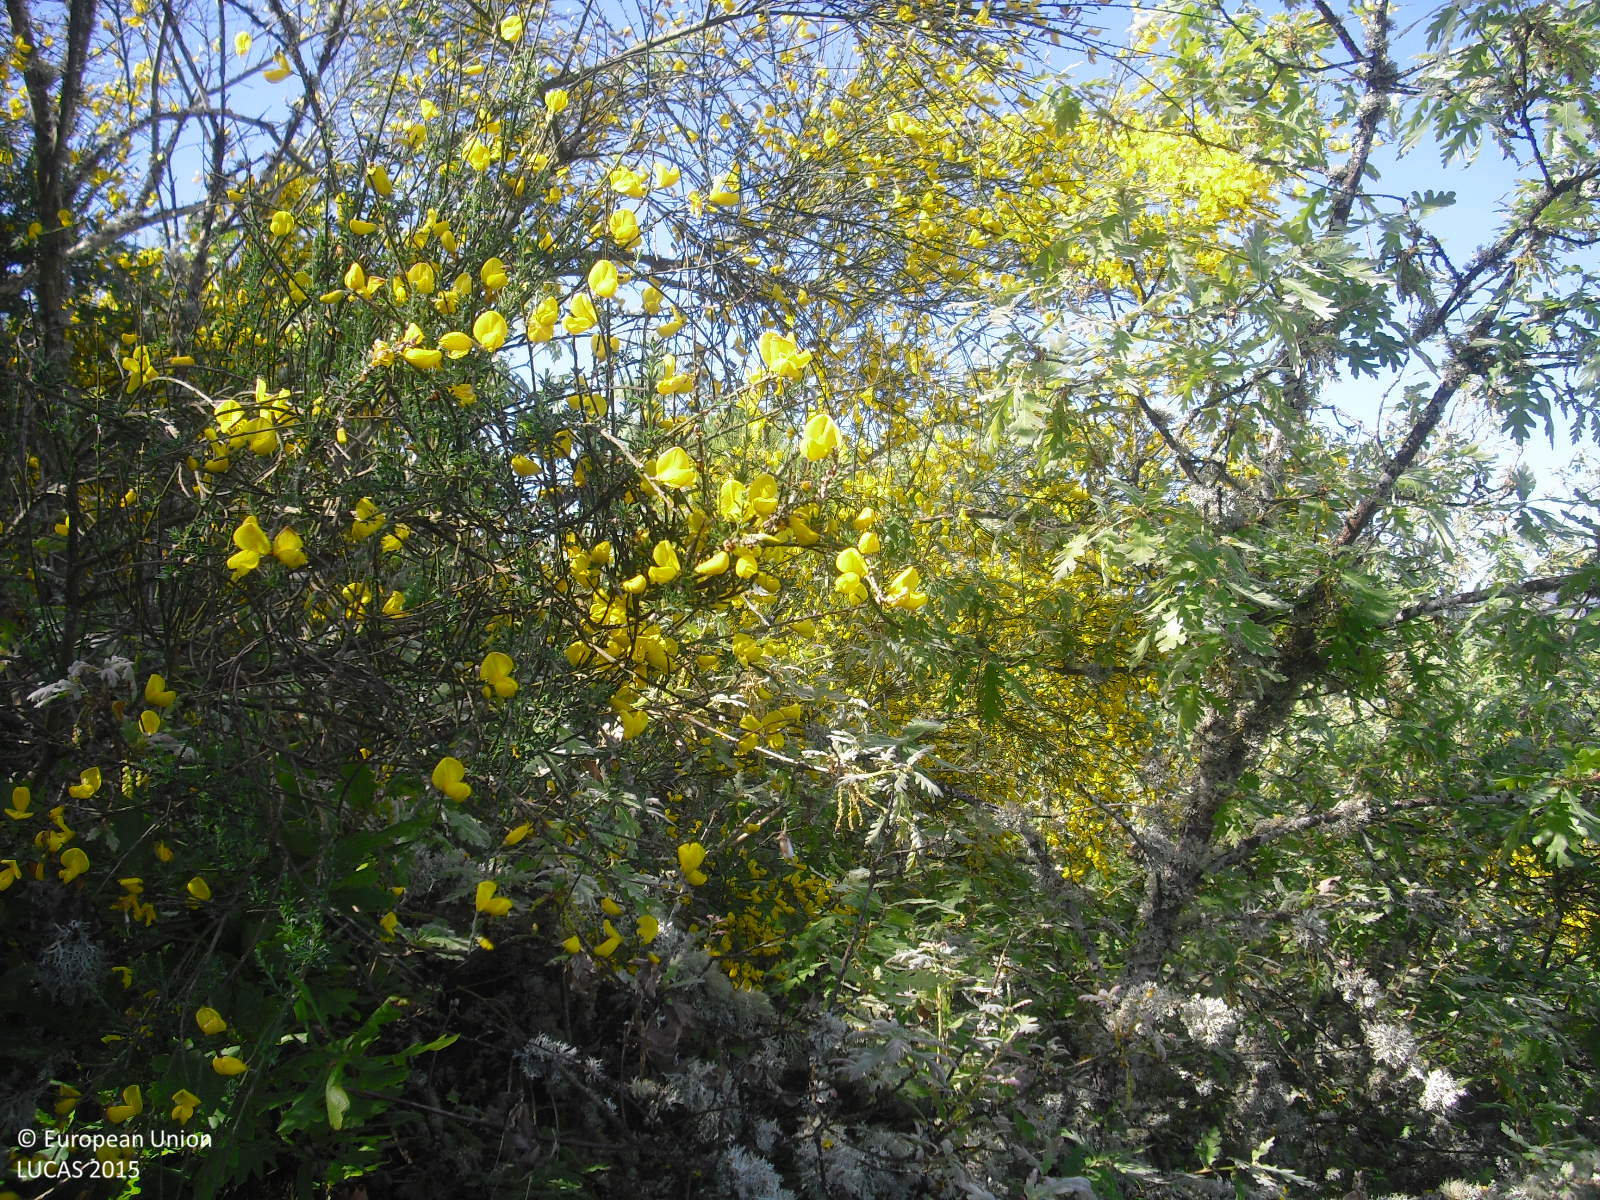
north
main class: Woodland
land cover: Broadleaved woodland
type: acidophilous oak and oak-birch forest
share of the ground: 25 - 50 %
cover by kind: shrubs 50 %, broadleaved forest trees 40 %, herbaceous plants 10 %
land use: Semi-natural and natural areas not in use
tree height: < 5 m
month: May
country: ES
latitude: 42.1240
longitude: -7.7435
